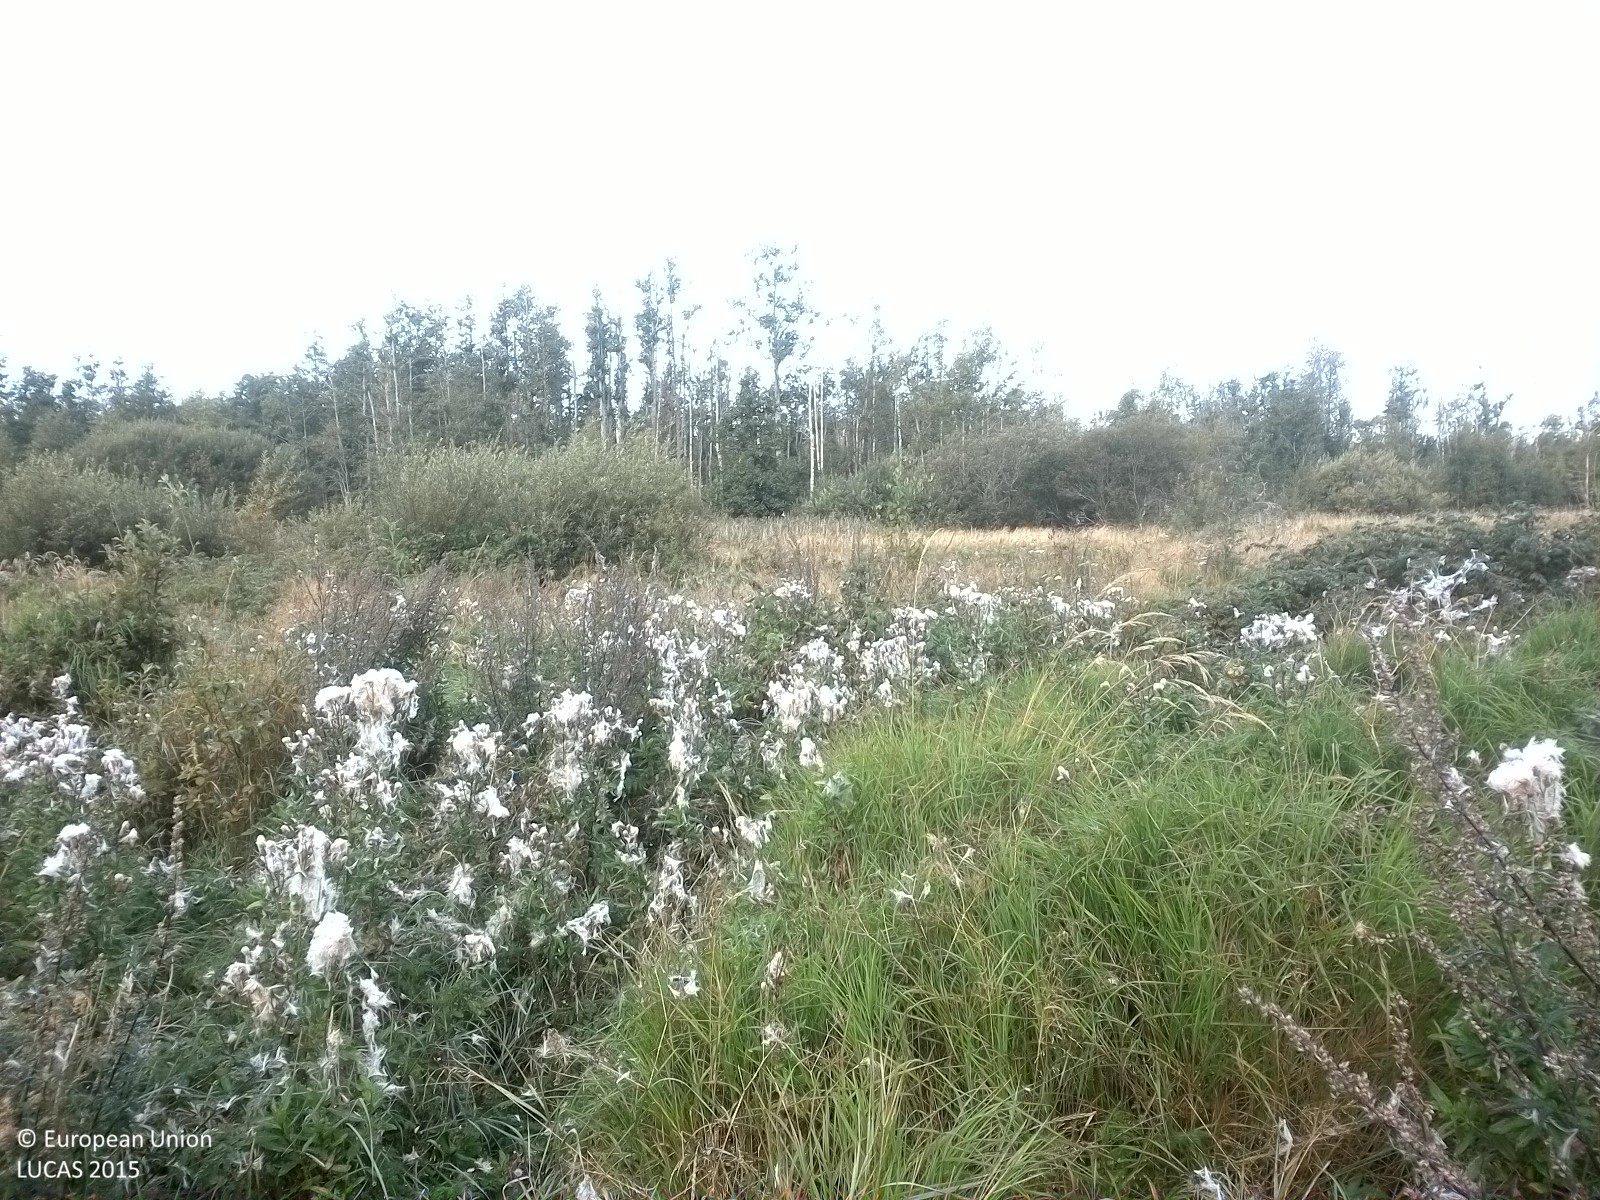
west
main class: Grassland
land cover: Spontaneously vegetated surfaces
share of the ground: > 75 %
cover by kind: herbaceous plants 100 %
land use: Semi-natural and natural areas not in use
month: August
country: SE
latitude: 59.3088
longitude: 15.6654
